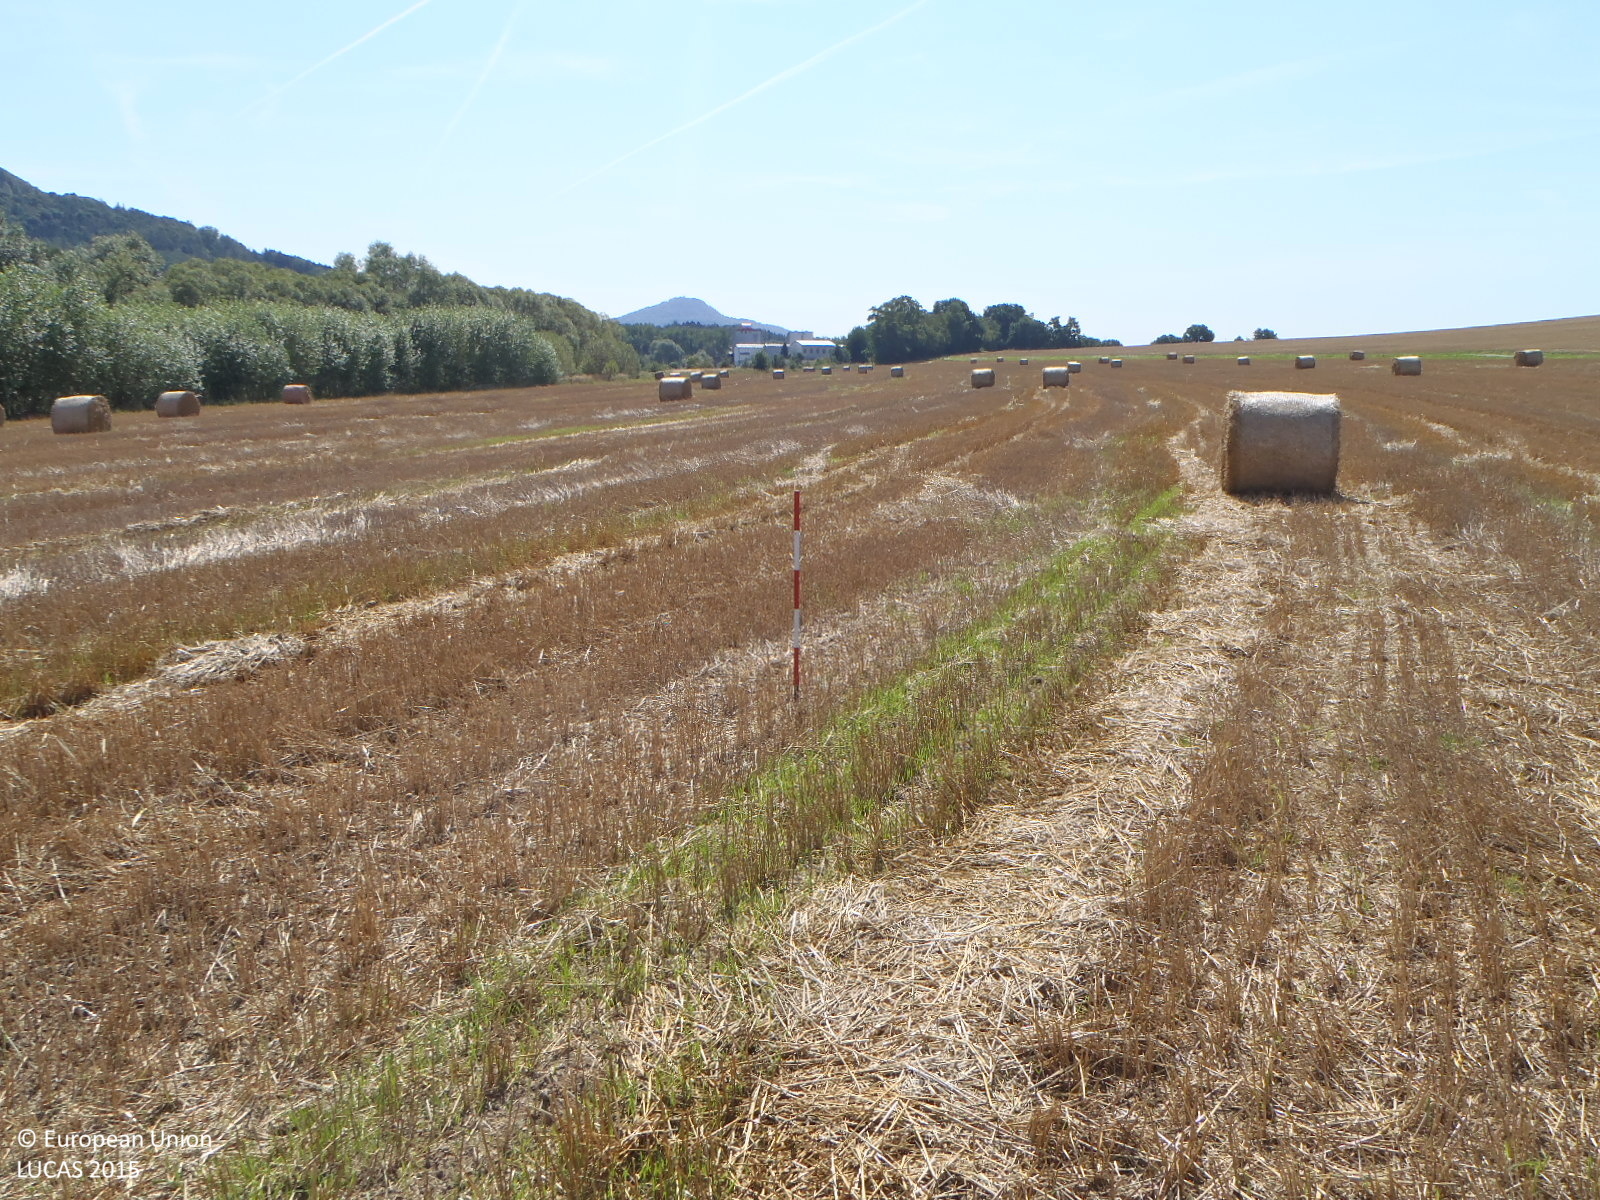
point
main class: Cropland
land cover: Common wheat
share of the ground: > 75 %
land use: Agriculture (excluding fallow land and kitchen gardens)
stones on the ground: < 10 %
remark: Harvested field
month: August
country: CZ
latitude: 50.7350
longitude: 14.7205
